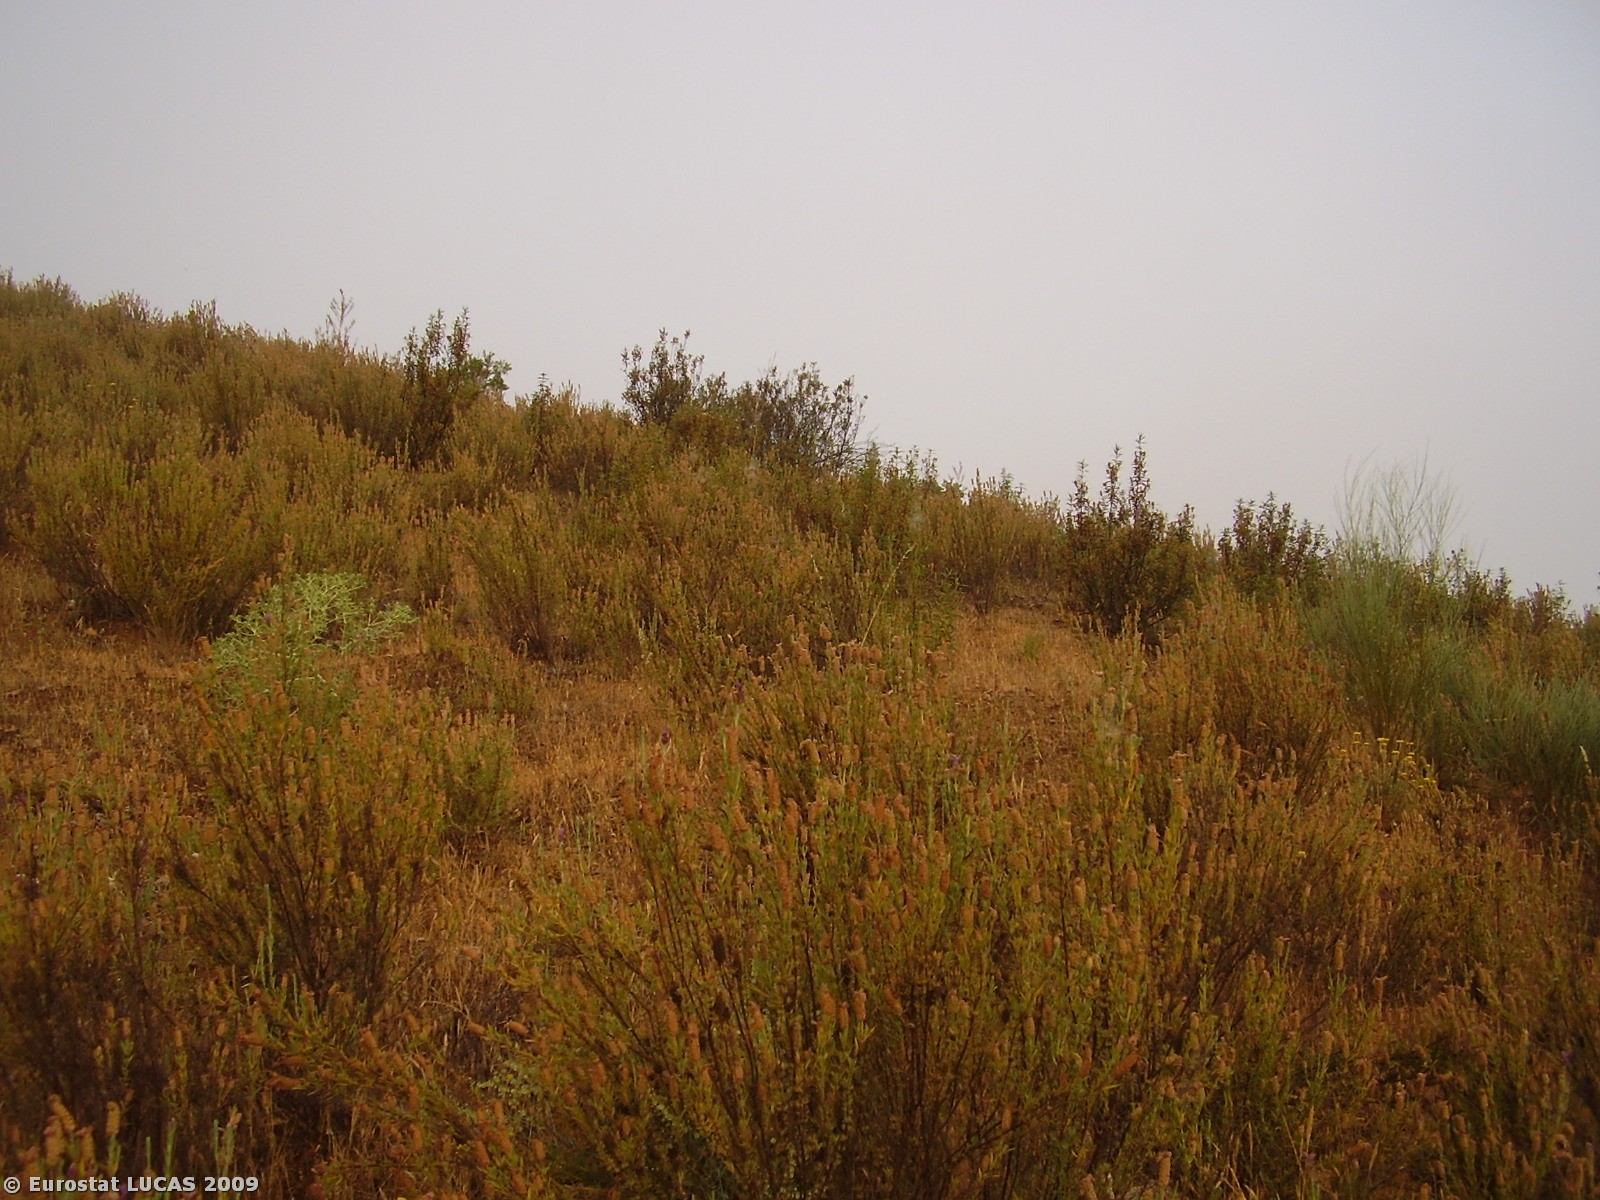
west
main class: Shrubland
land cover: Shrubland with sparse tree cover
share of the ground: 25 - 50 %
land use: Unused
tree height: > 5 m
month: May
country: PT
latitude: 37.6388
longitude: -7.6371
